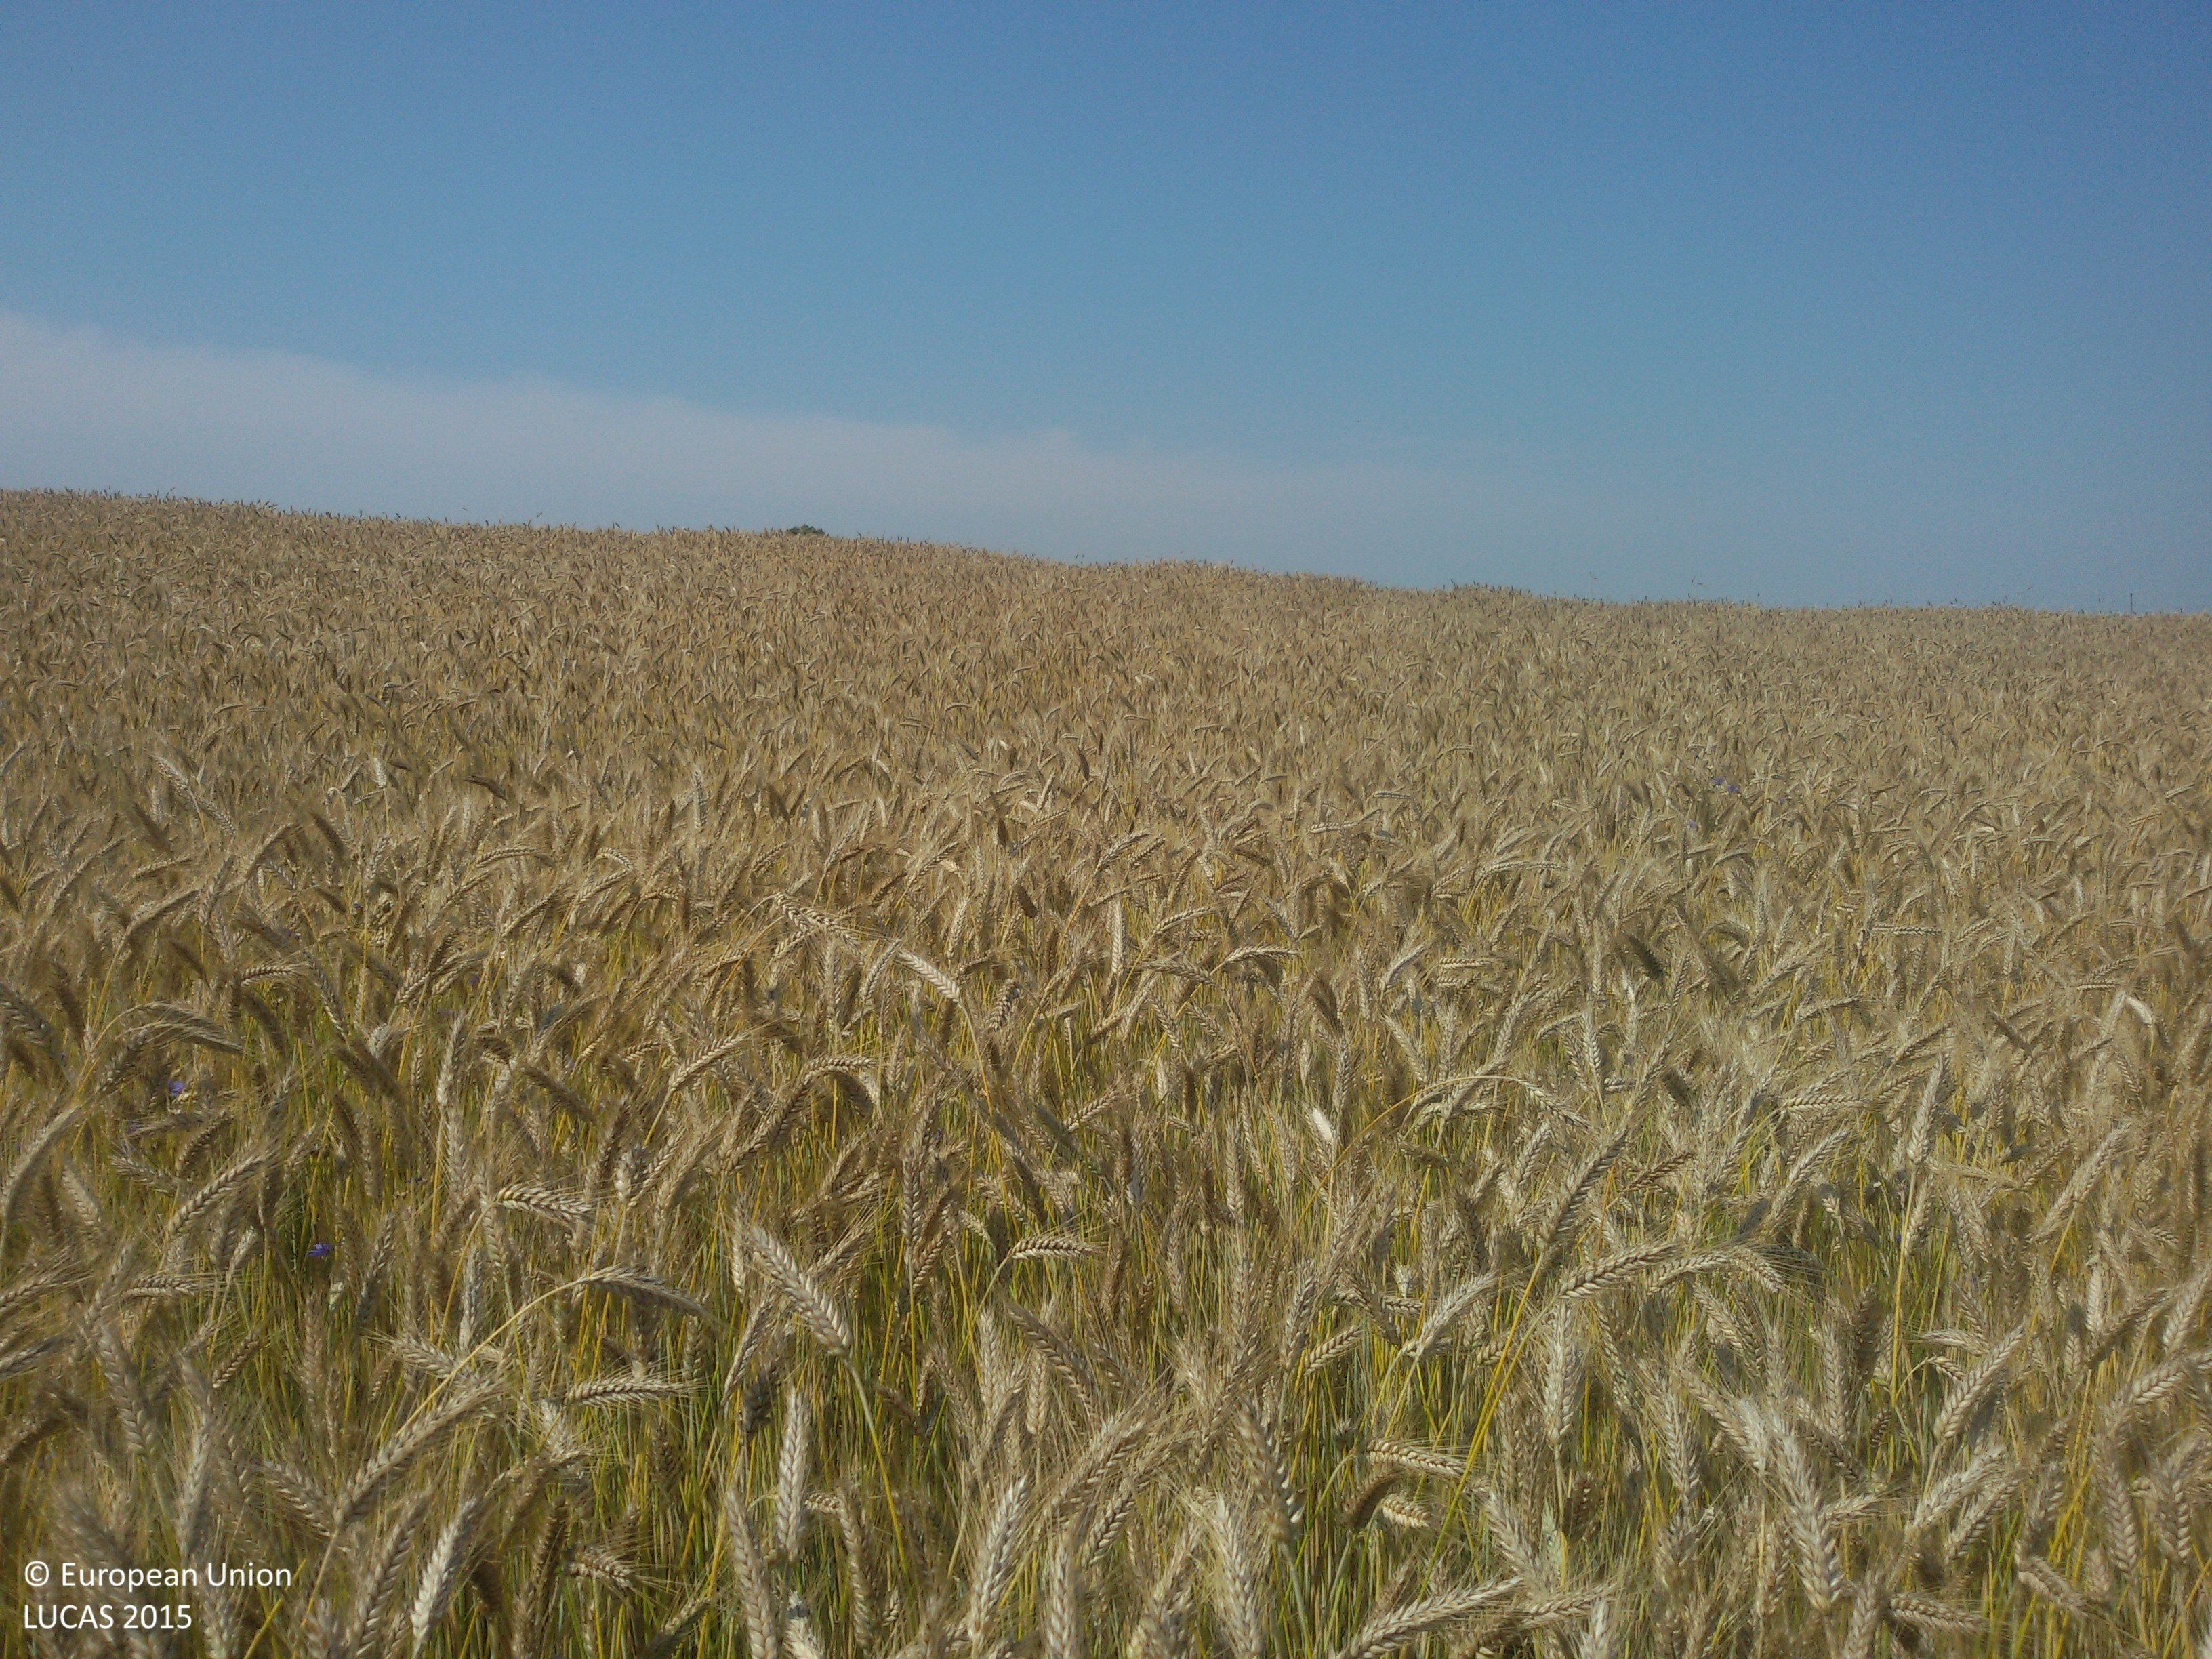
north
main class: Cropland
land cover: Triticale
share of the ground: > 75 %
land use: Agriculture (excluding fallow land and kitchen gardens)
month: July
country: PL
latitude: 53.3361
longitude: 17.7172
